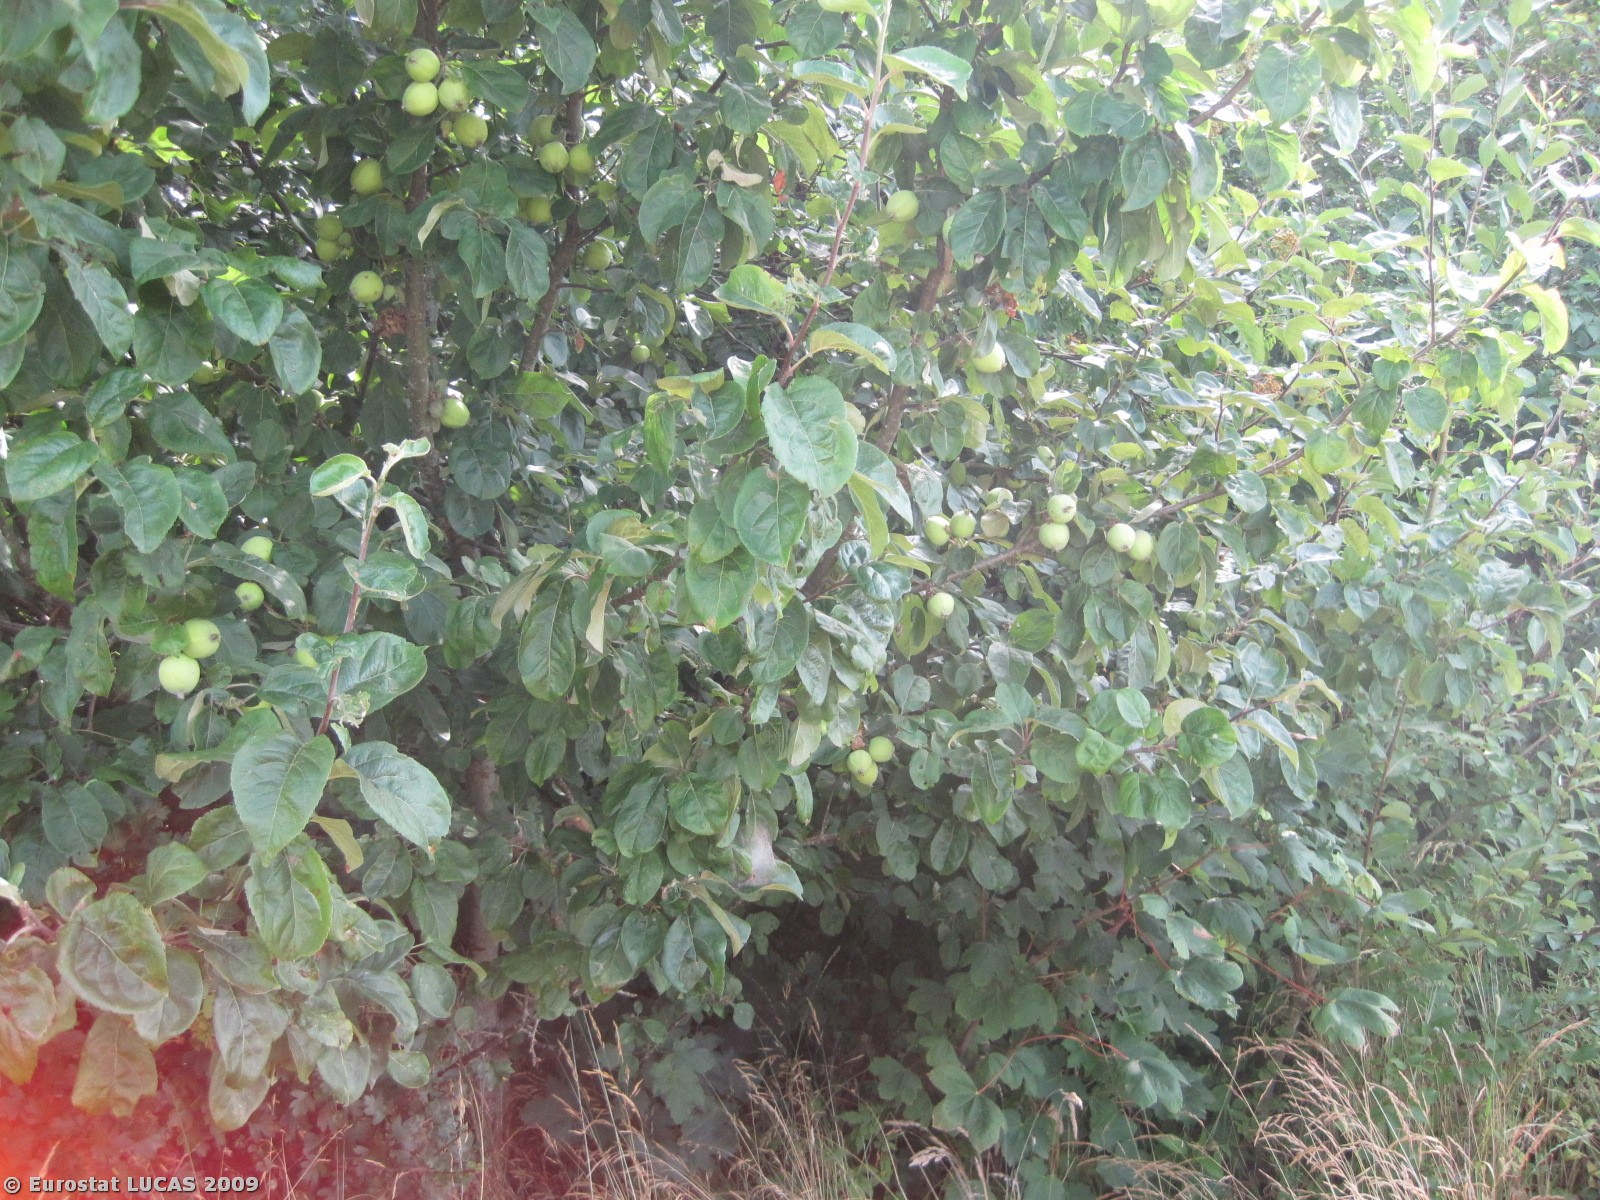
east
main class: Cropland
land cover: Rape and turnip rape
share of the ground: > 75 %
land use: Agriculture (excluding fallow land and kitchen gardens)
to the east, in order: Rape and turnip rape; Grass margins; Broadleaved woodland; Abandoned hedges; Grass margins; Tracks; Abandoned hedges; Grassland with sparse tree/shrub cover; Artificial constructions in urban areas; Grassland with sparse tree/shrub cover; Abandoned hedges
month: July
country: DK
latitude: 56.6190
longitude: 9.7884
